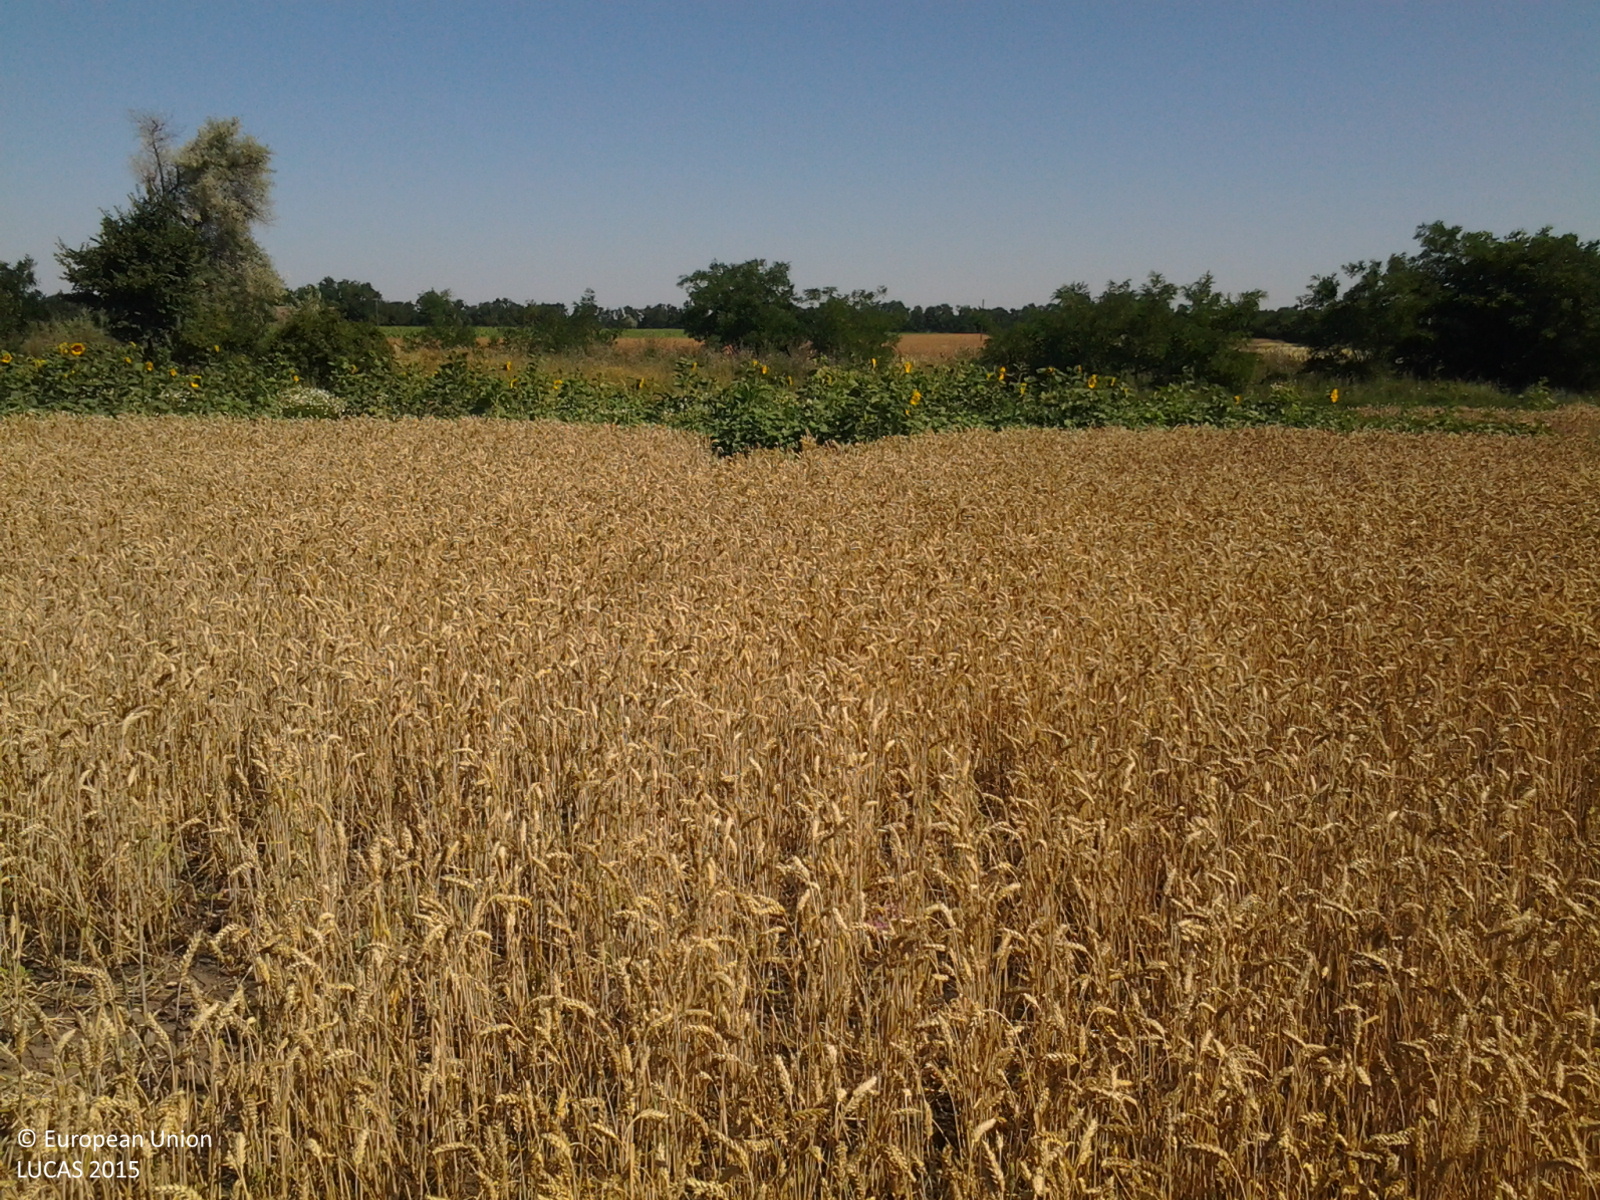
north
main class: Cropland
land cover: Common wheat
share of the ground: > 75 %
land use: Agriculture (excluding fallow land and kitchen gardens)
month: July
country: HU
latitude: 47.0117
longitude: 20.5128
